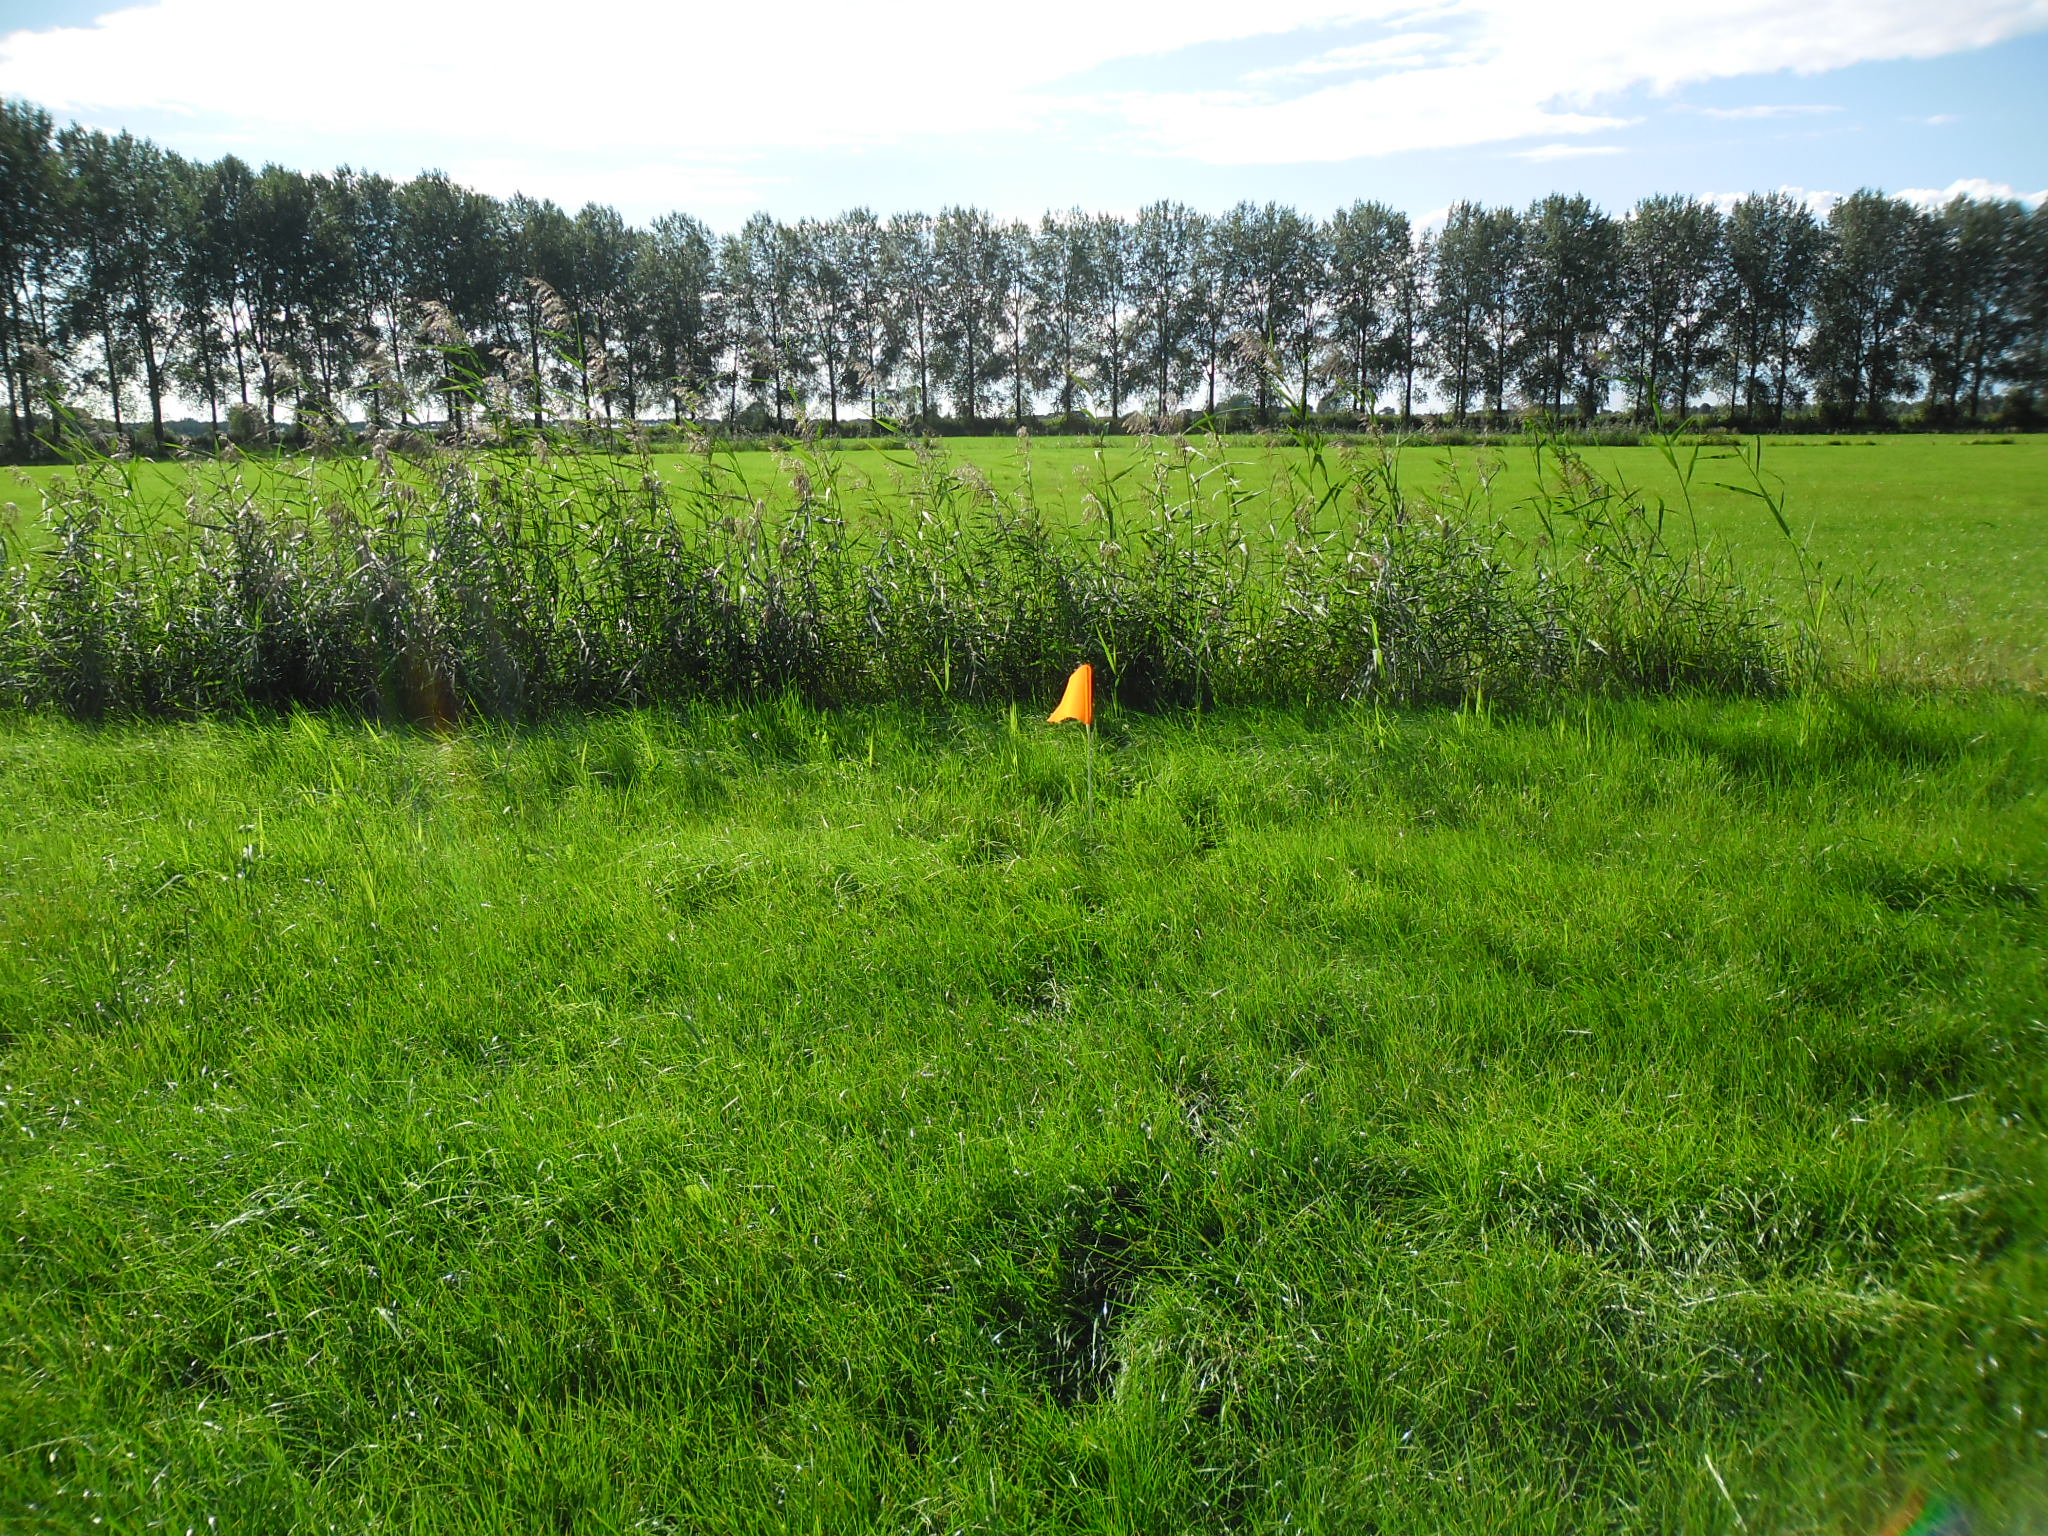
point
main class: Grassland
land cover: Grassland without tree/shrub cover
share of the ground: > 75 %
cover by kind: herbaceous plants 100 %
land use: Agriculture (excluding fallow land and kitchen gardens)
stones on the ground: < 10 %
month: September
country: NL
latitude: 52.0834
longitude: 6.2198
